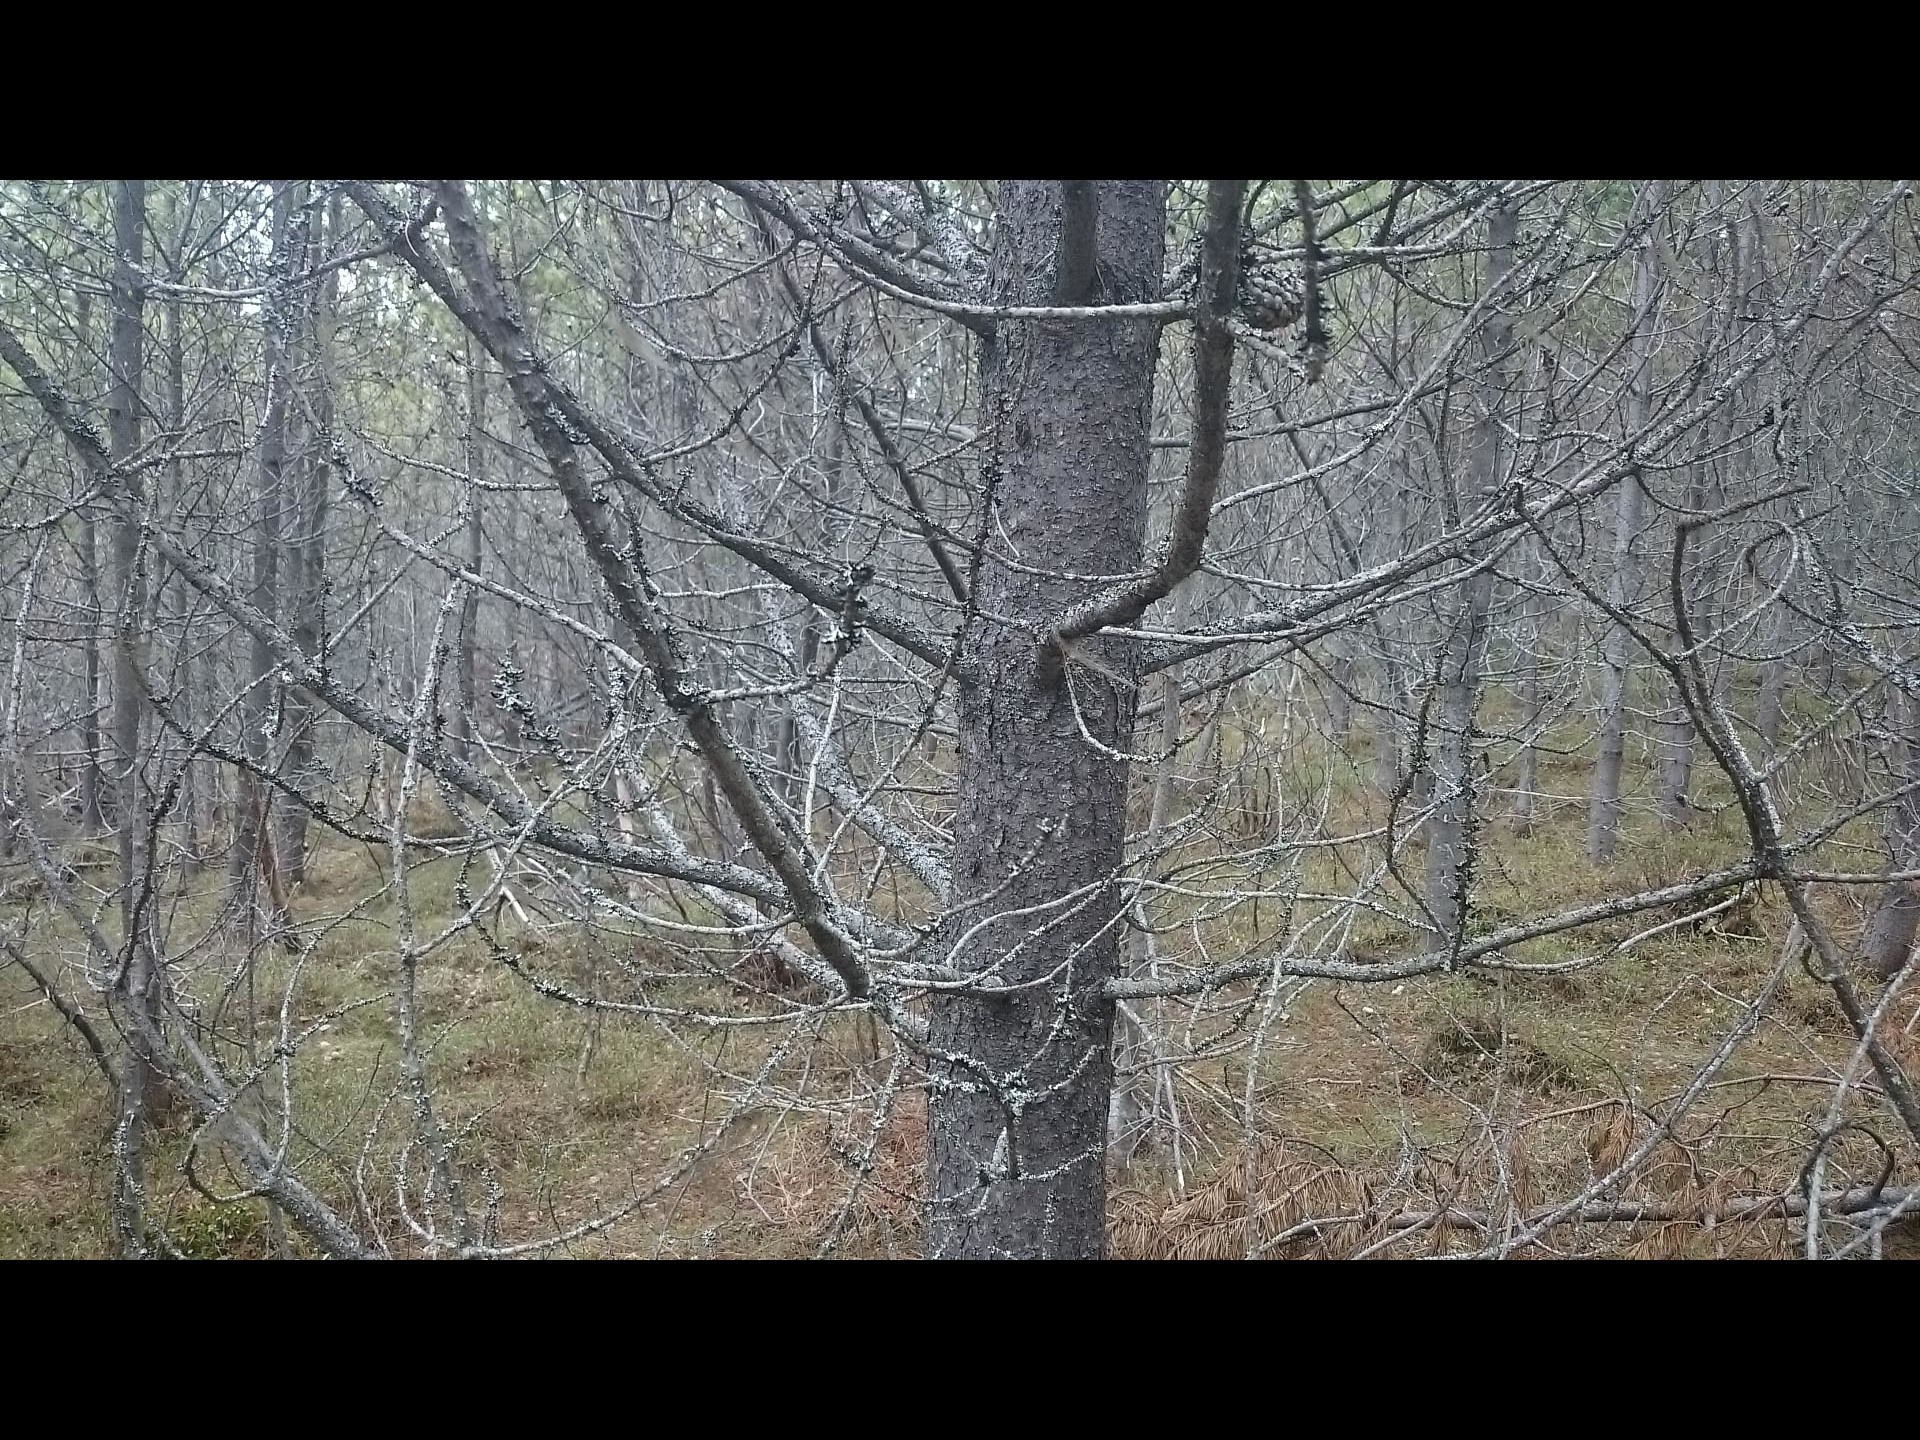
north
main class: Woodland
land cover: Pine dominated coniferous woodland
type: exotic forest
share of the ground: > 75 %
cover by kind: coniferous forest trees 90 %, lichens and mosses 10 %
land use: Forestry
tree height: > 5 m
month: June
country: SE
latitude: 63.7379
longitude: 13.8080
